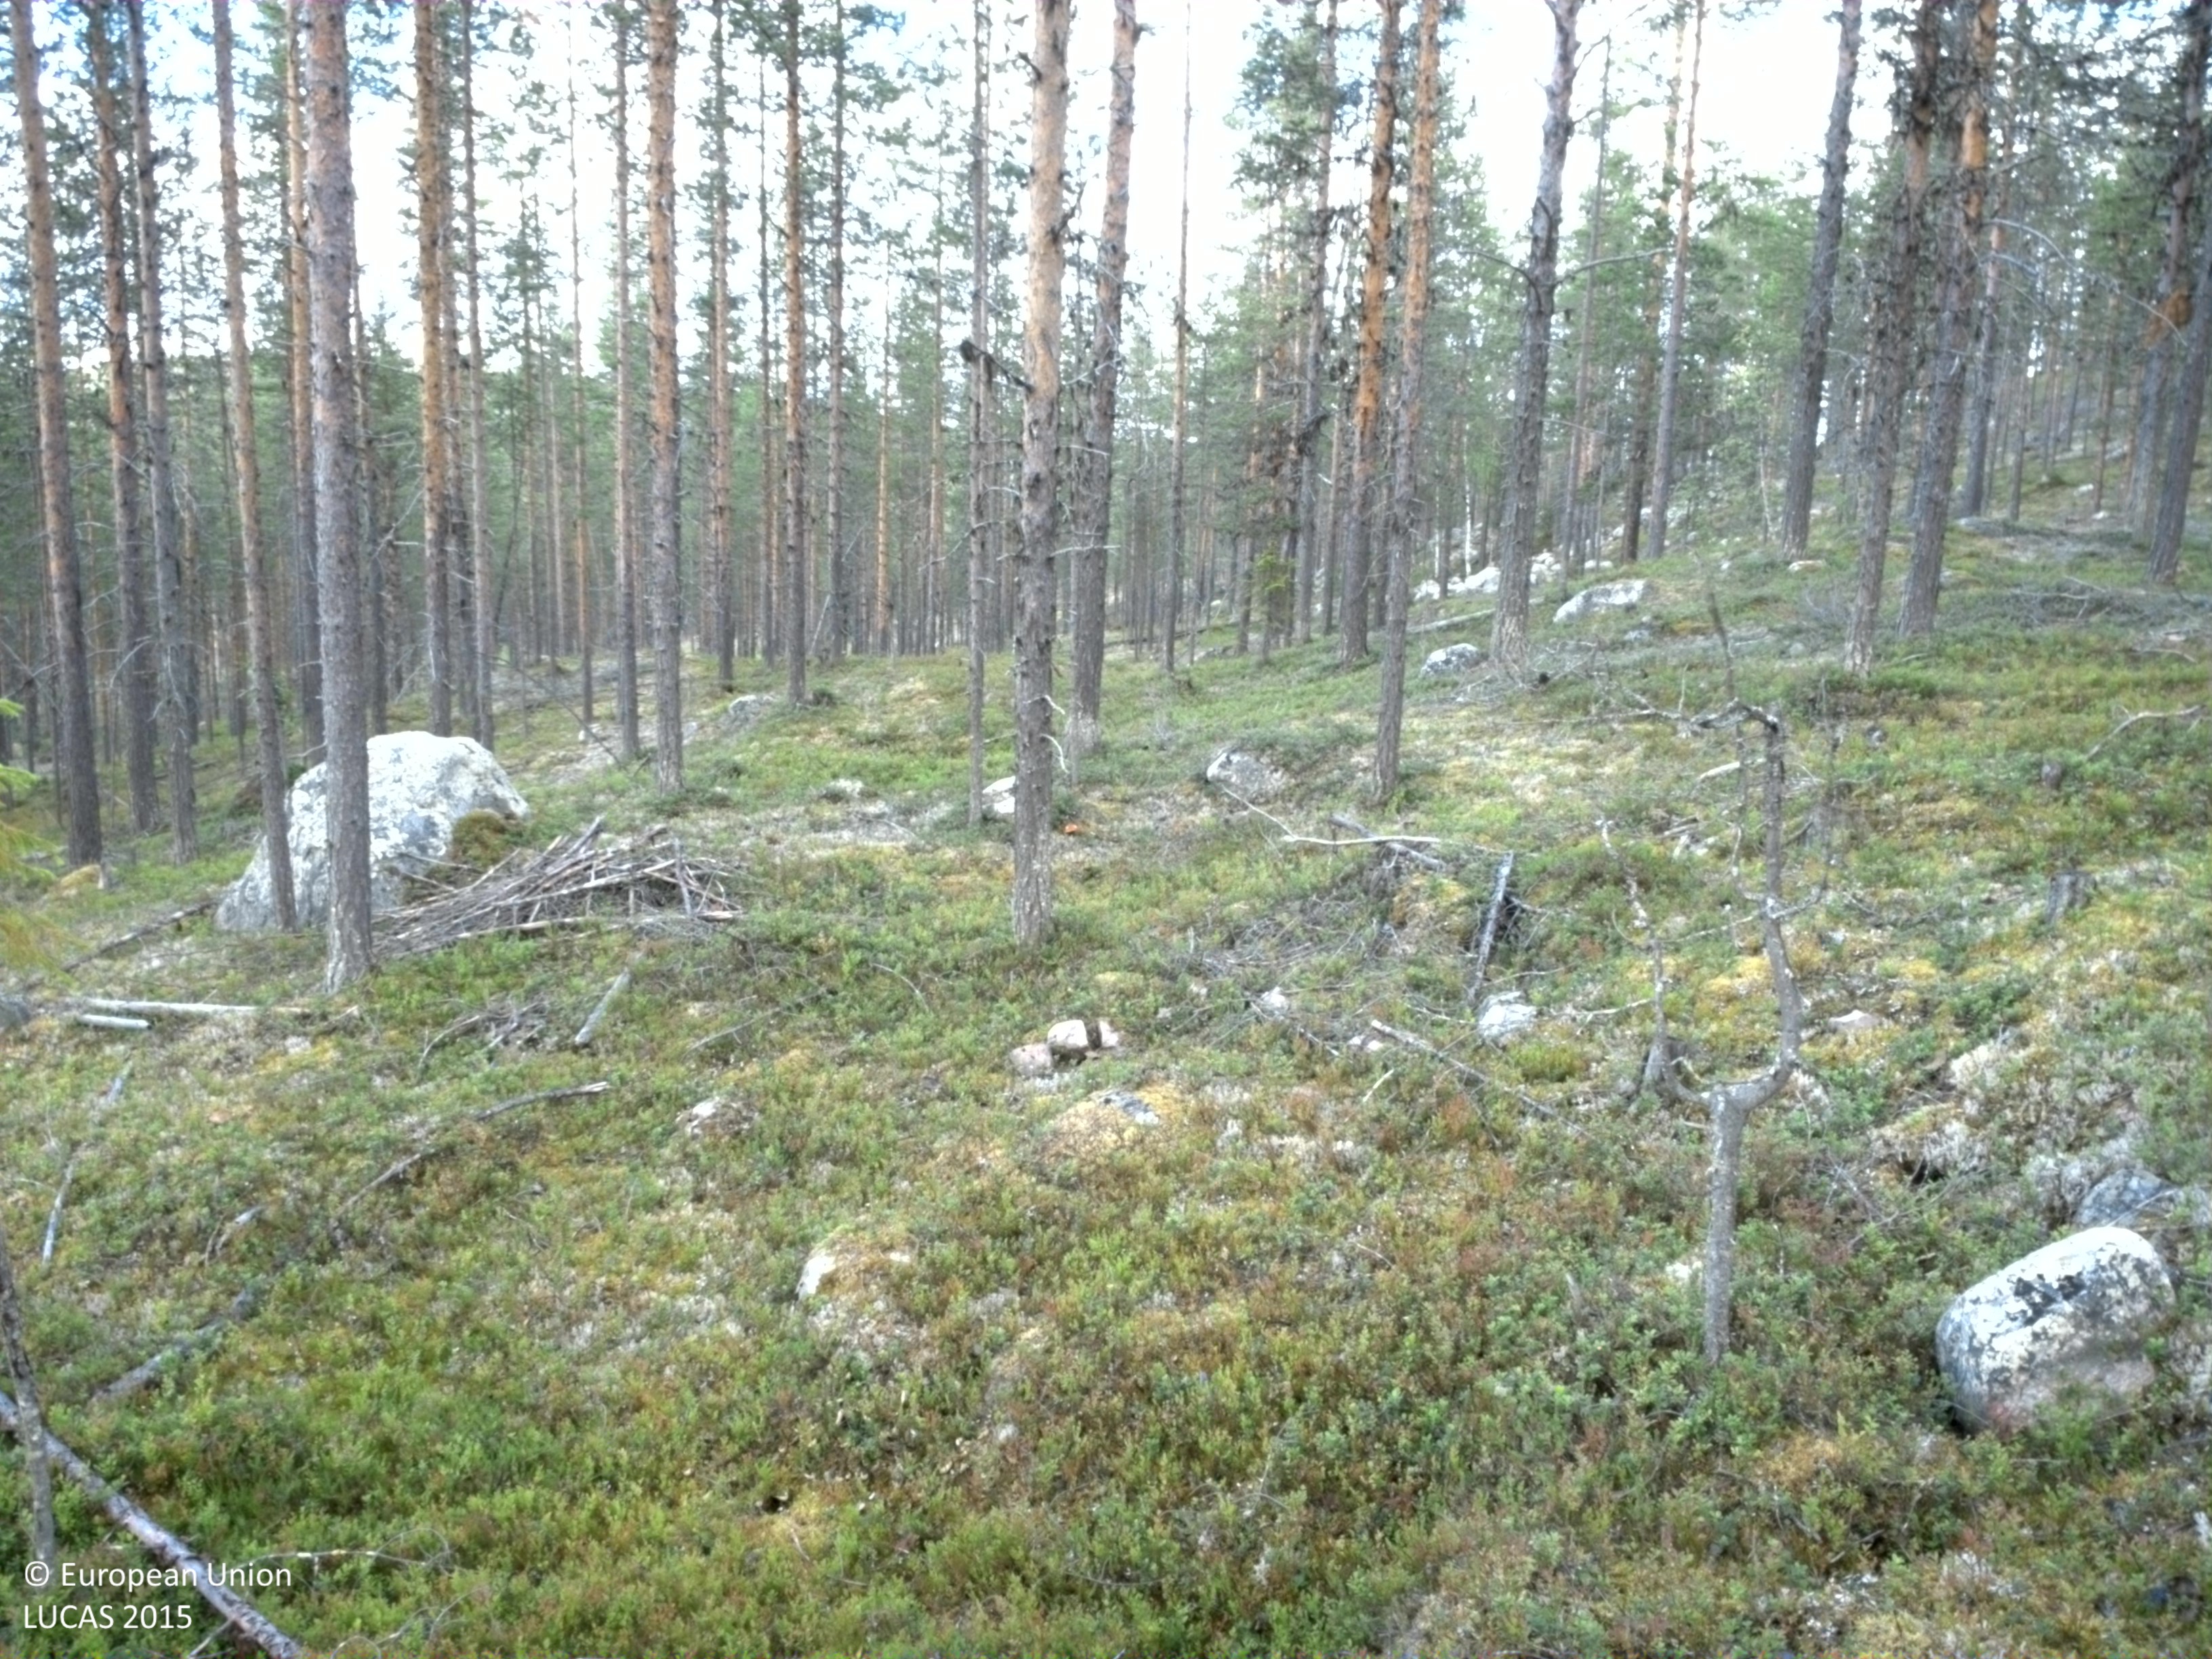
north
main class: Woodland
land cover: Pine dominated coniferous woodland
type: boreal forest
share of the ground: 25 - 50 %
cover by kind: shrubs 60 %, coniferous forest trees 30 %, lichens and mosses 5 %, consolidated bare surface 5 %
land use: Forestry
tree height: > 5 m
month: August
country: SE
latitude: 66.4481
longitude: 20.7005
